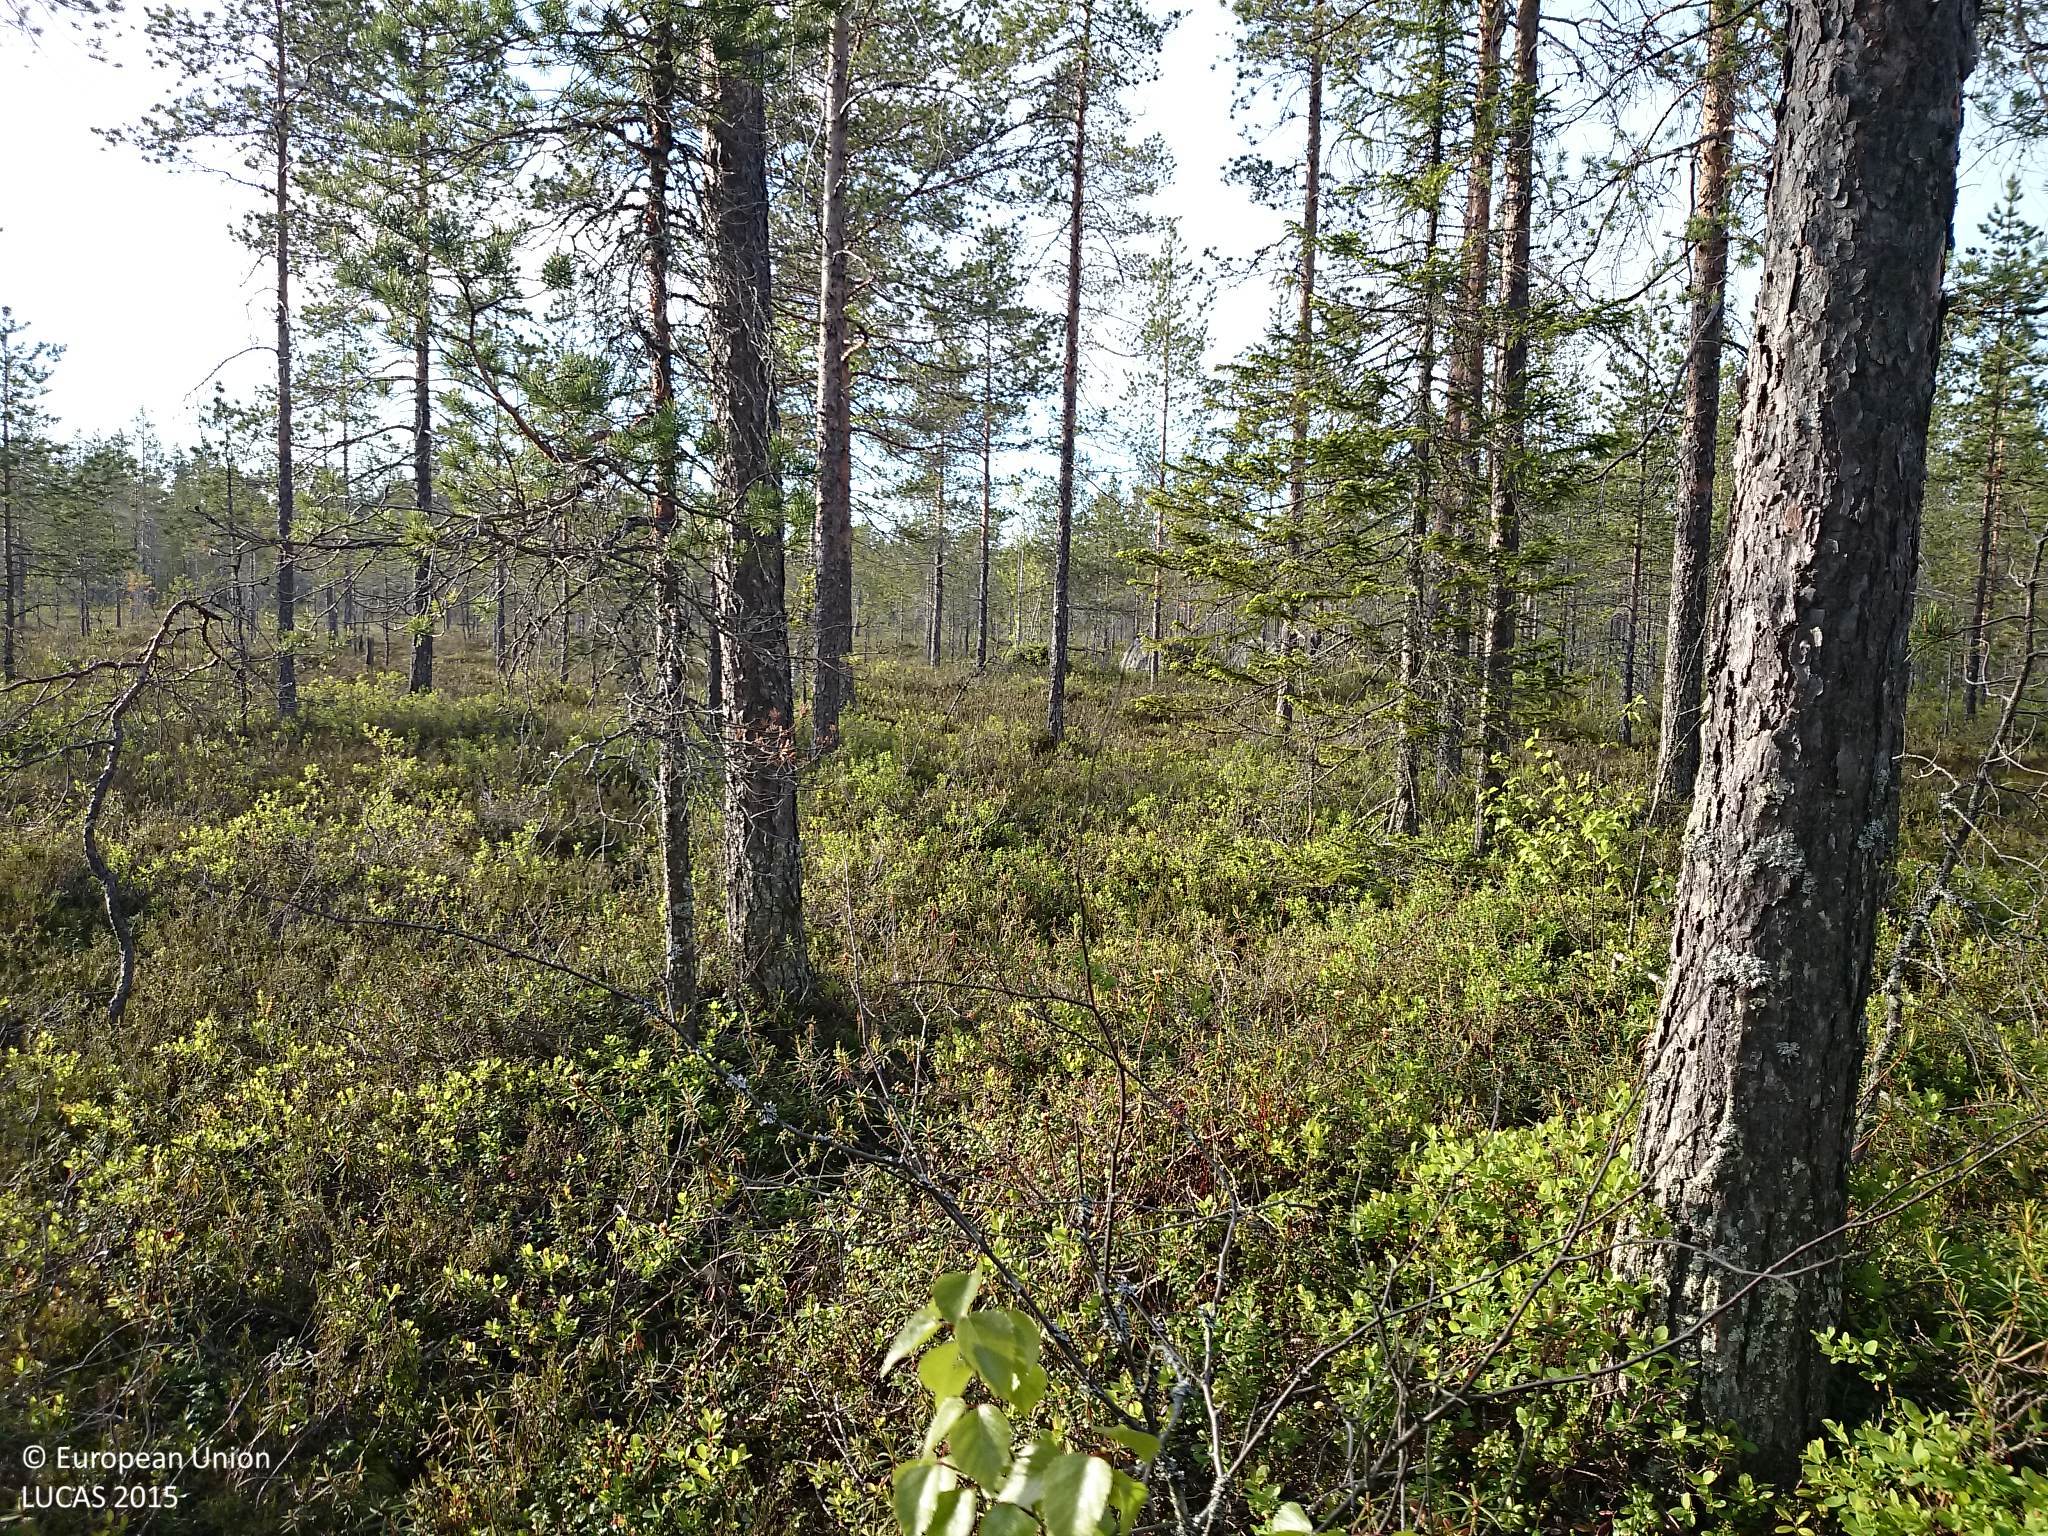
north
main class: Woodland
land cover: Pine dominated coniferous woodland
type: boreal forest
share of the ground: 50 - 75 %
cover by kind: coniferous forest trees 60 %, shrubs 40 %
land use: Forestry
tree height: > 5 m
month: June
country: SE
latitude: 64.0596
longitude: 20.6163
